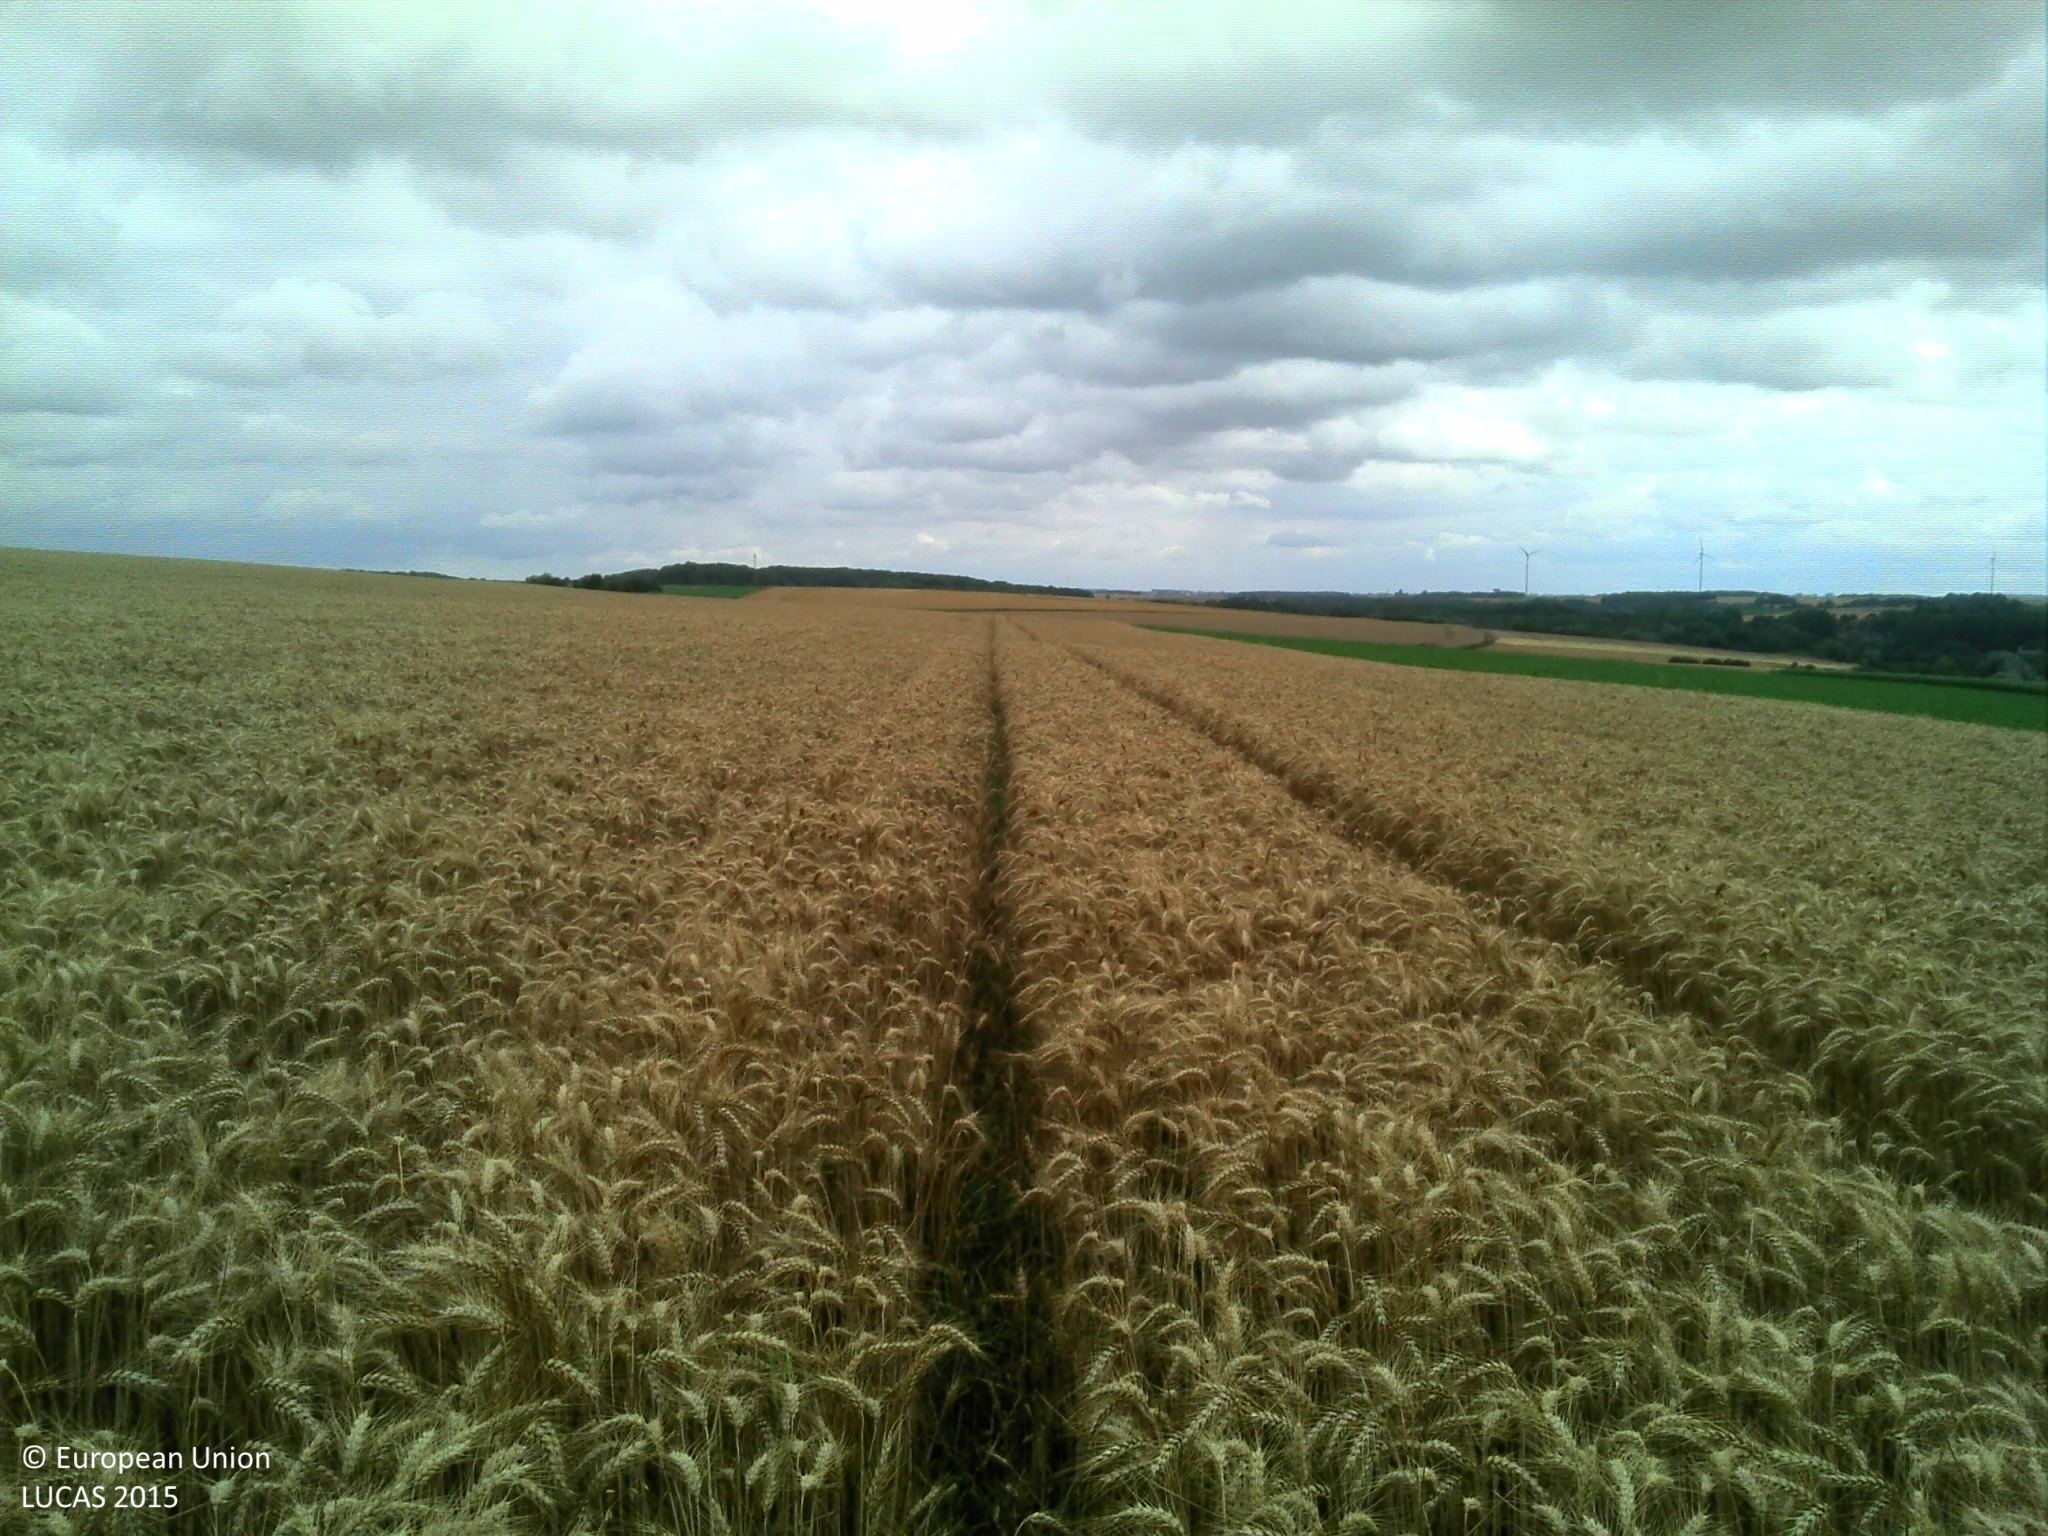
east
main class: Cropland
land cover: Common wheat
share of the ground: > 75 %
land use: Agriculture (excluding fallow land and kitchen gardens)
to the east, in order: Common wheat
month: July
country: FR
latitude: 49.8320
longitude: 2.5501
